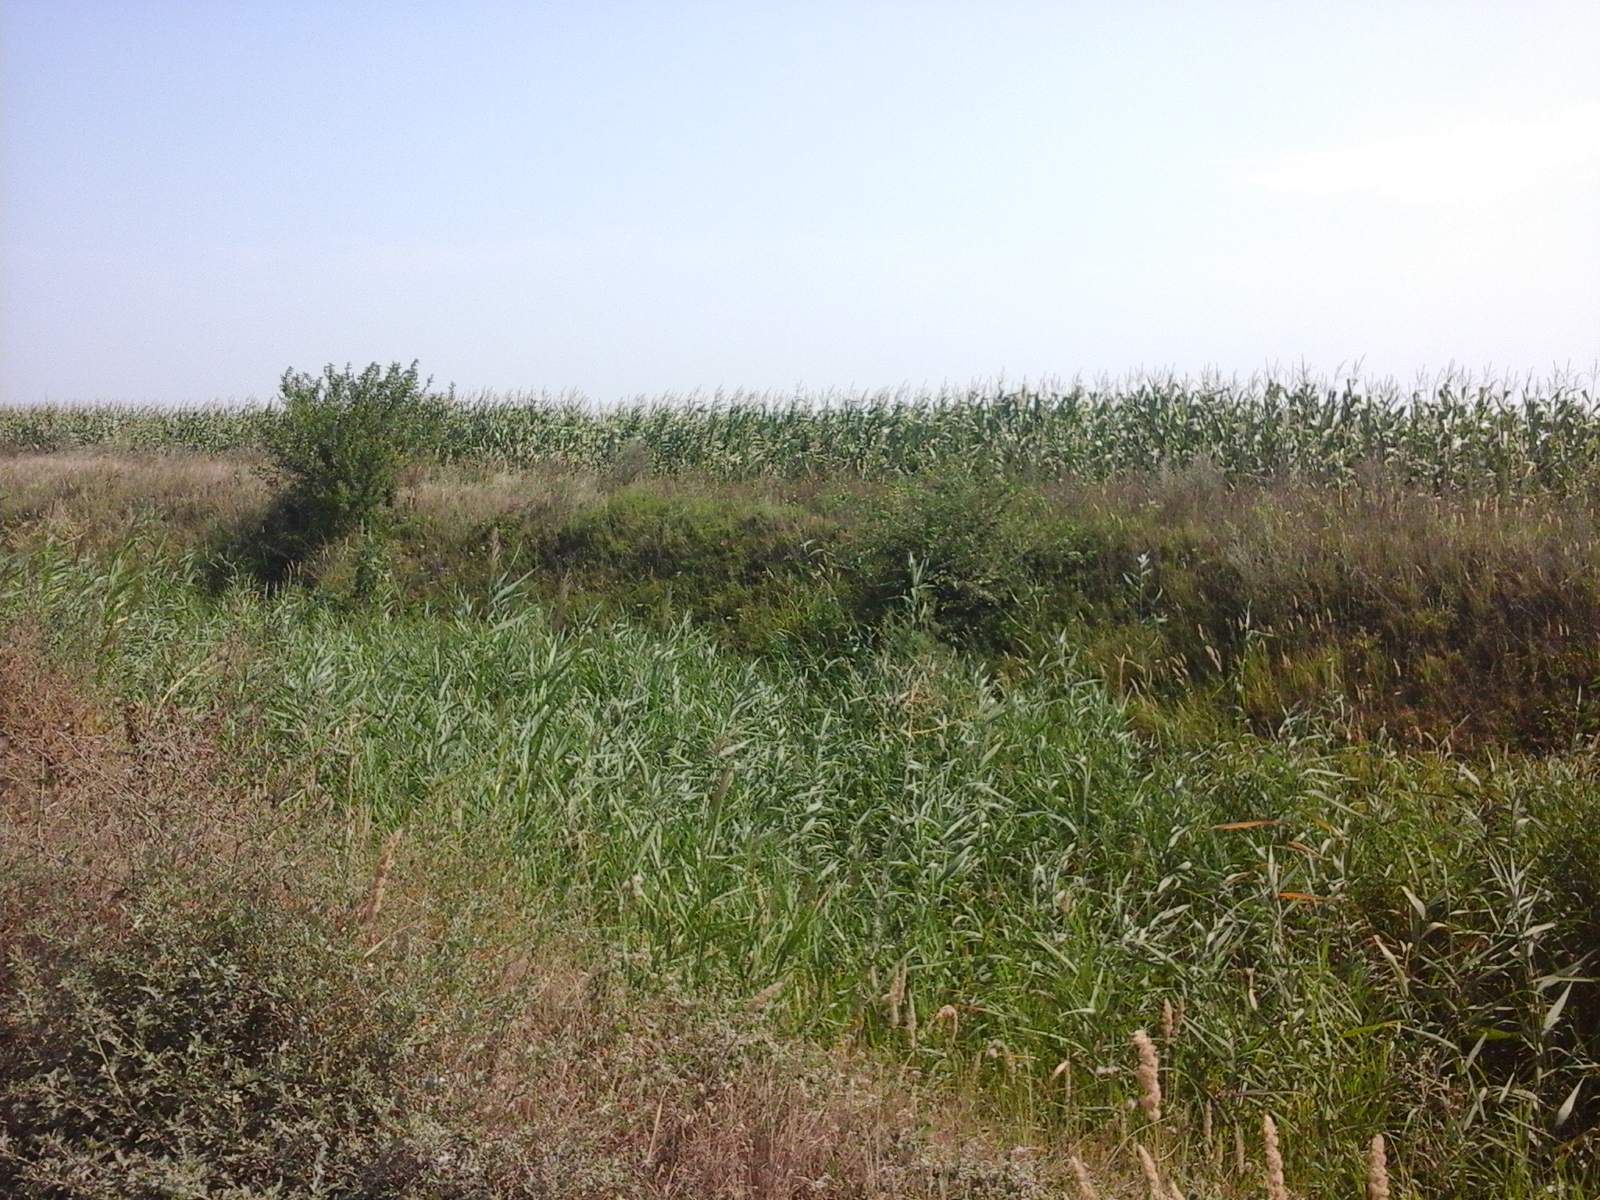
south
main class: Cropland
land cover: Maize
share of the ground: > 75 %
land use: Agriculture (excluding fallow land and kitchen gardens)
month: August
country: RO
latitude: 45.0593
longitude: 27.7182
